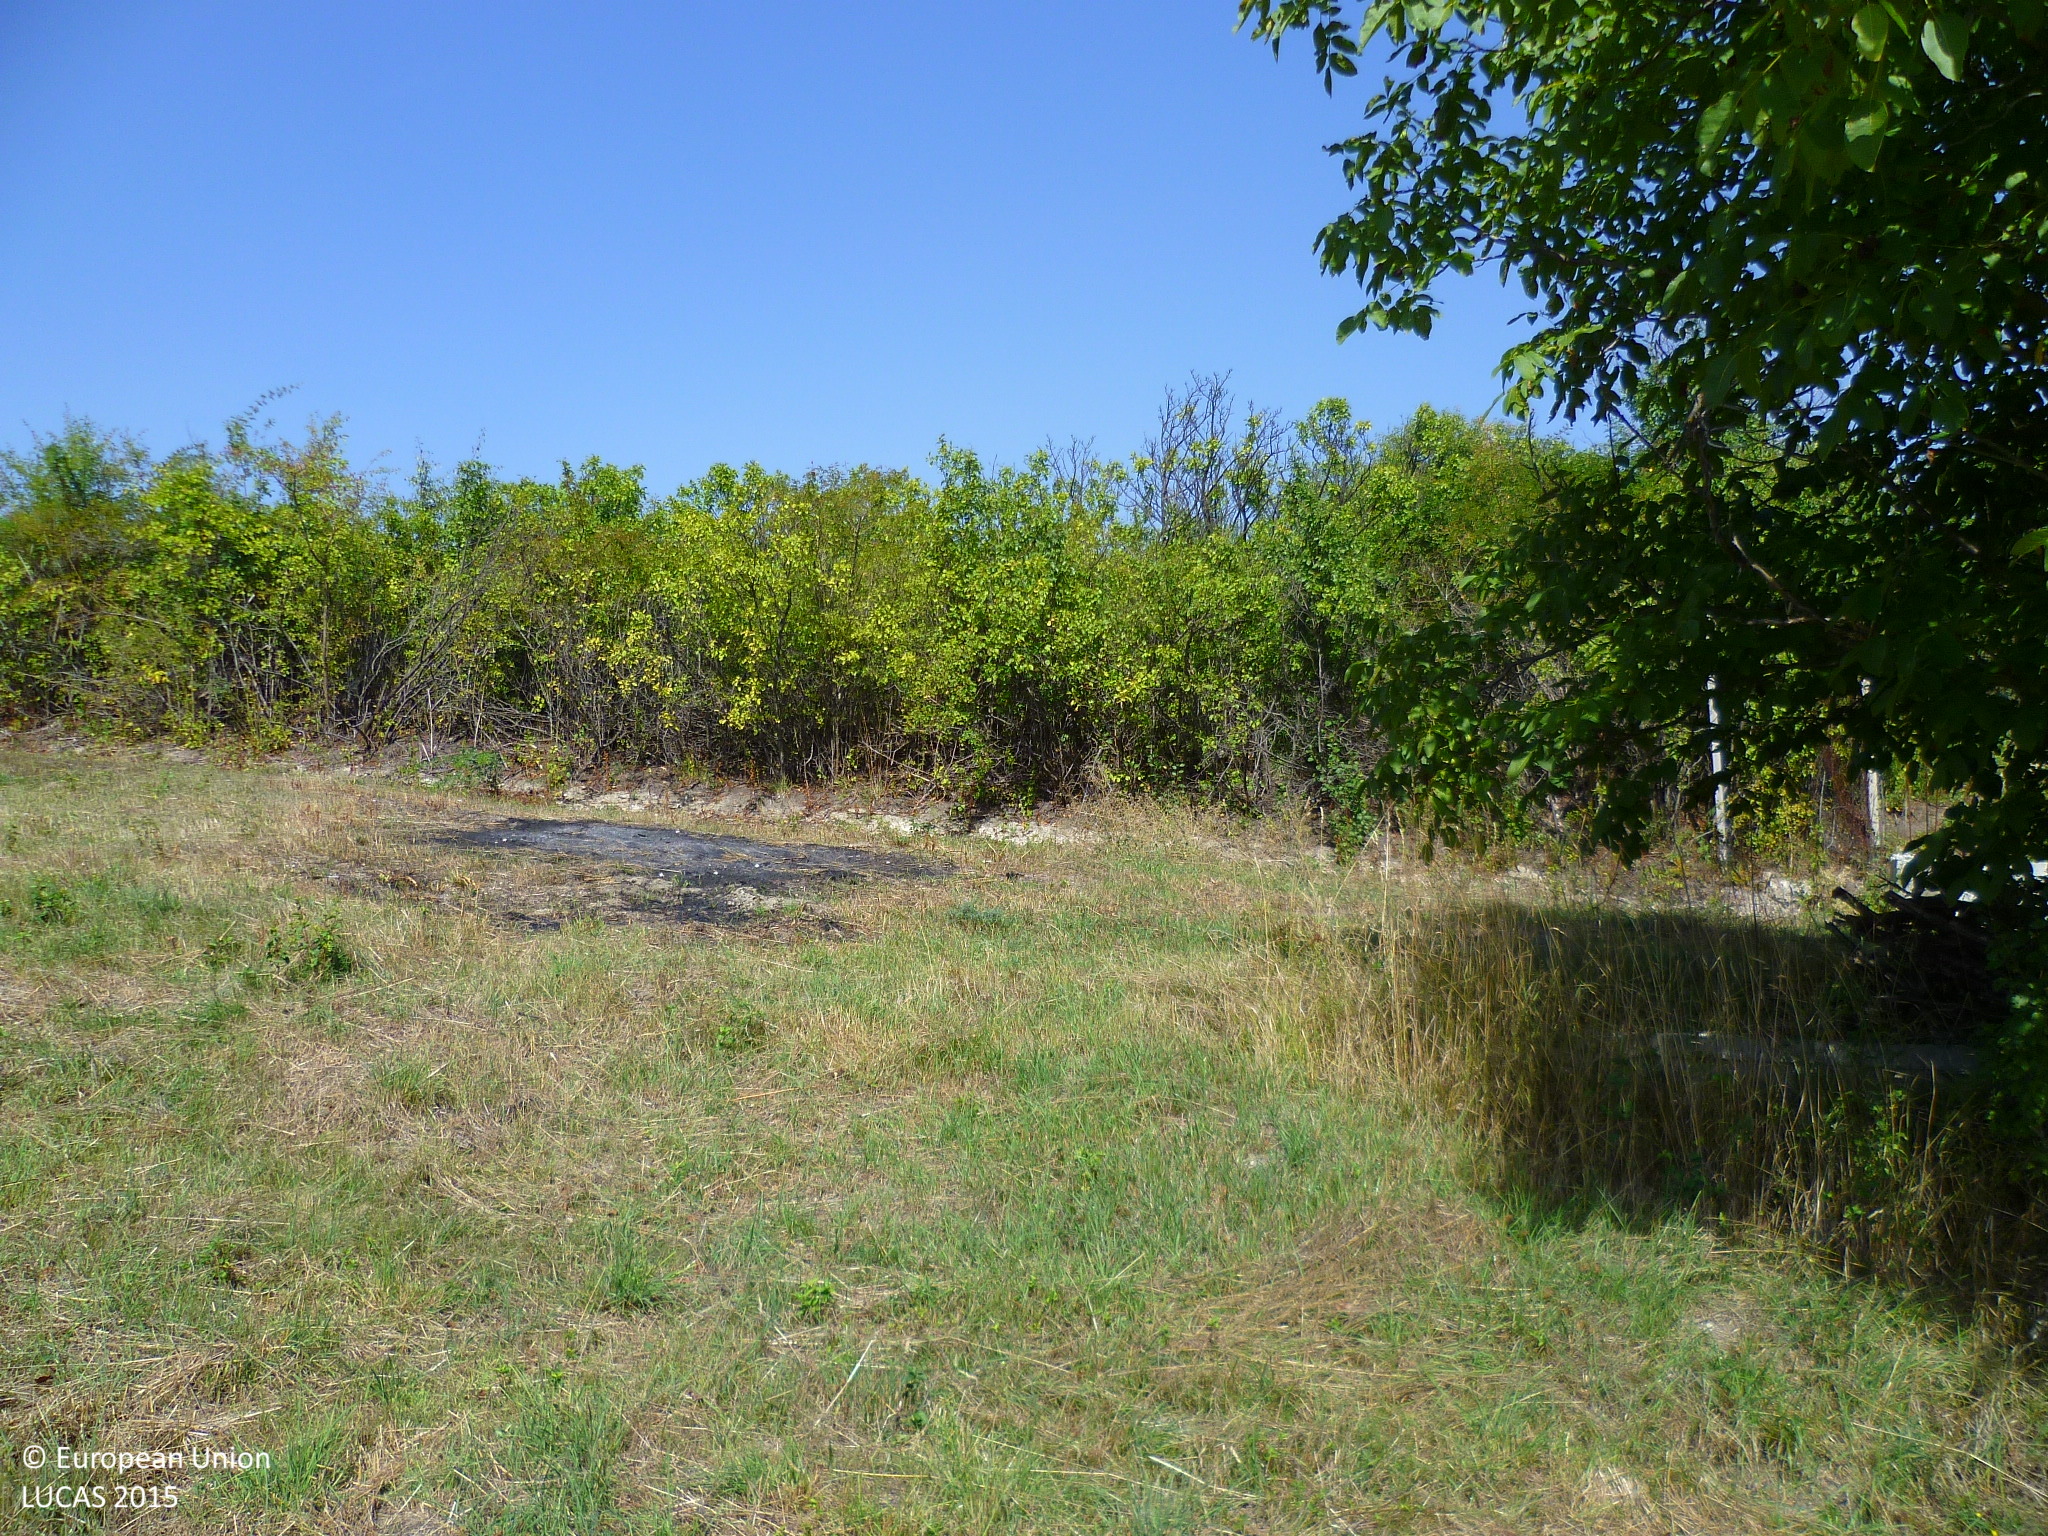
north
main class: Cropland
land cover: Apple fruit
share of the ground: 50 - 75 %
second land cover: Spontaneously vegetated surfaces
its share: 50 - 75 %
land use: Kitchen garden
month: September
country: BG
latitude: 42.6206
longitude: 22.9642
